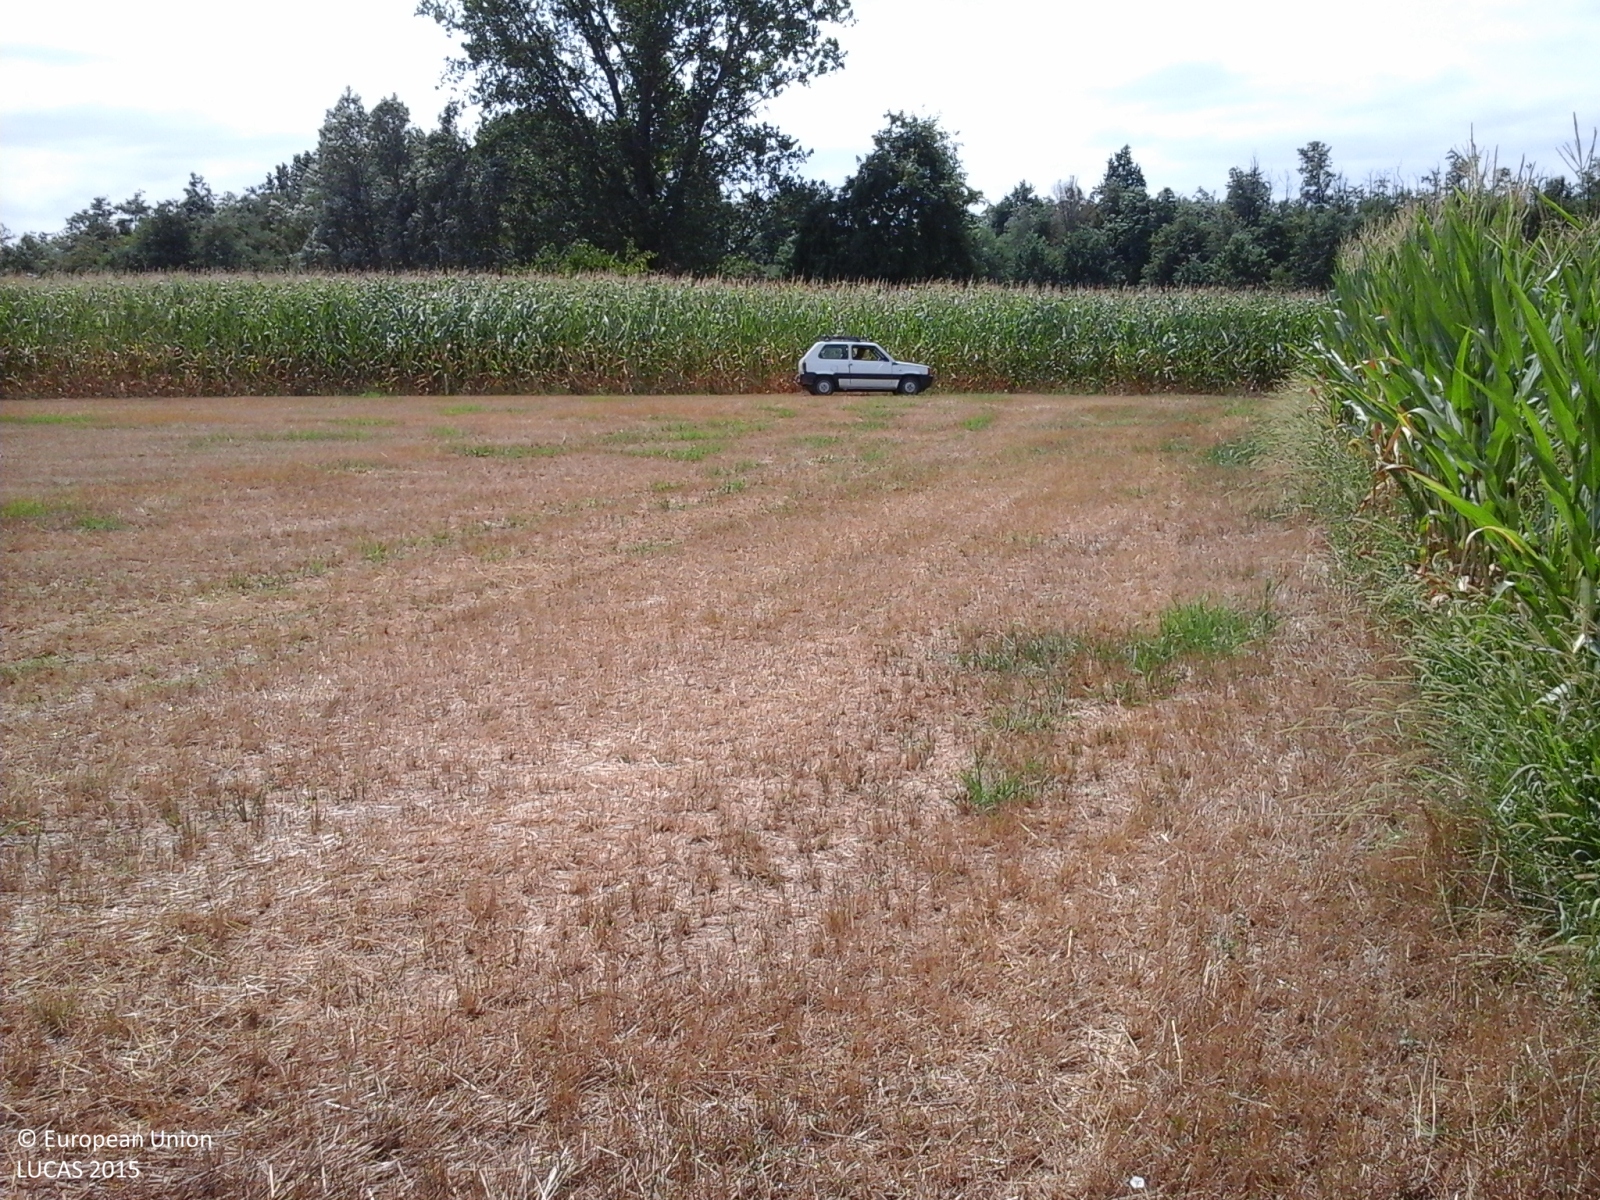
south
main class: Cropland
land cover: Maize
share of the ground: > 75 %
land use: Agriculture (excluding fallow land and kitchen gardens)
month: July
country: IT
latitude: 44.7966
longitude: 7.8173
